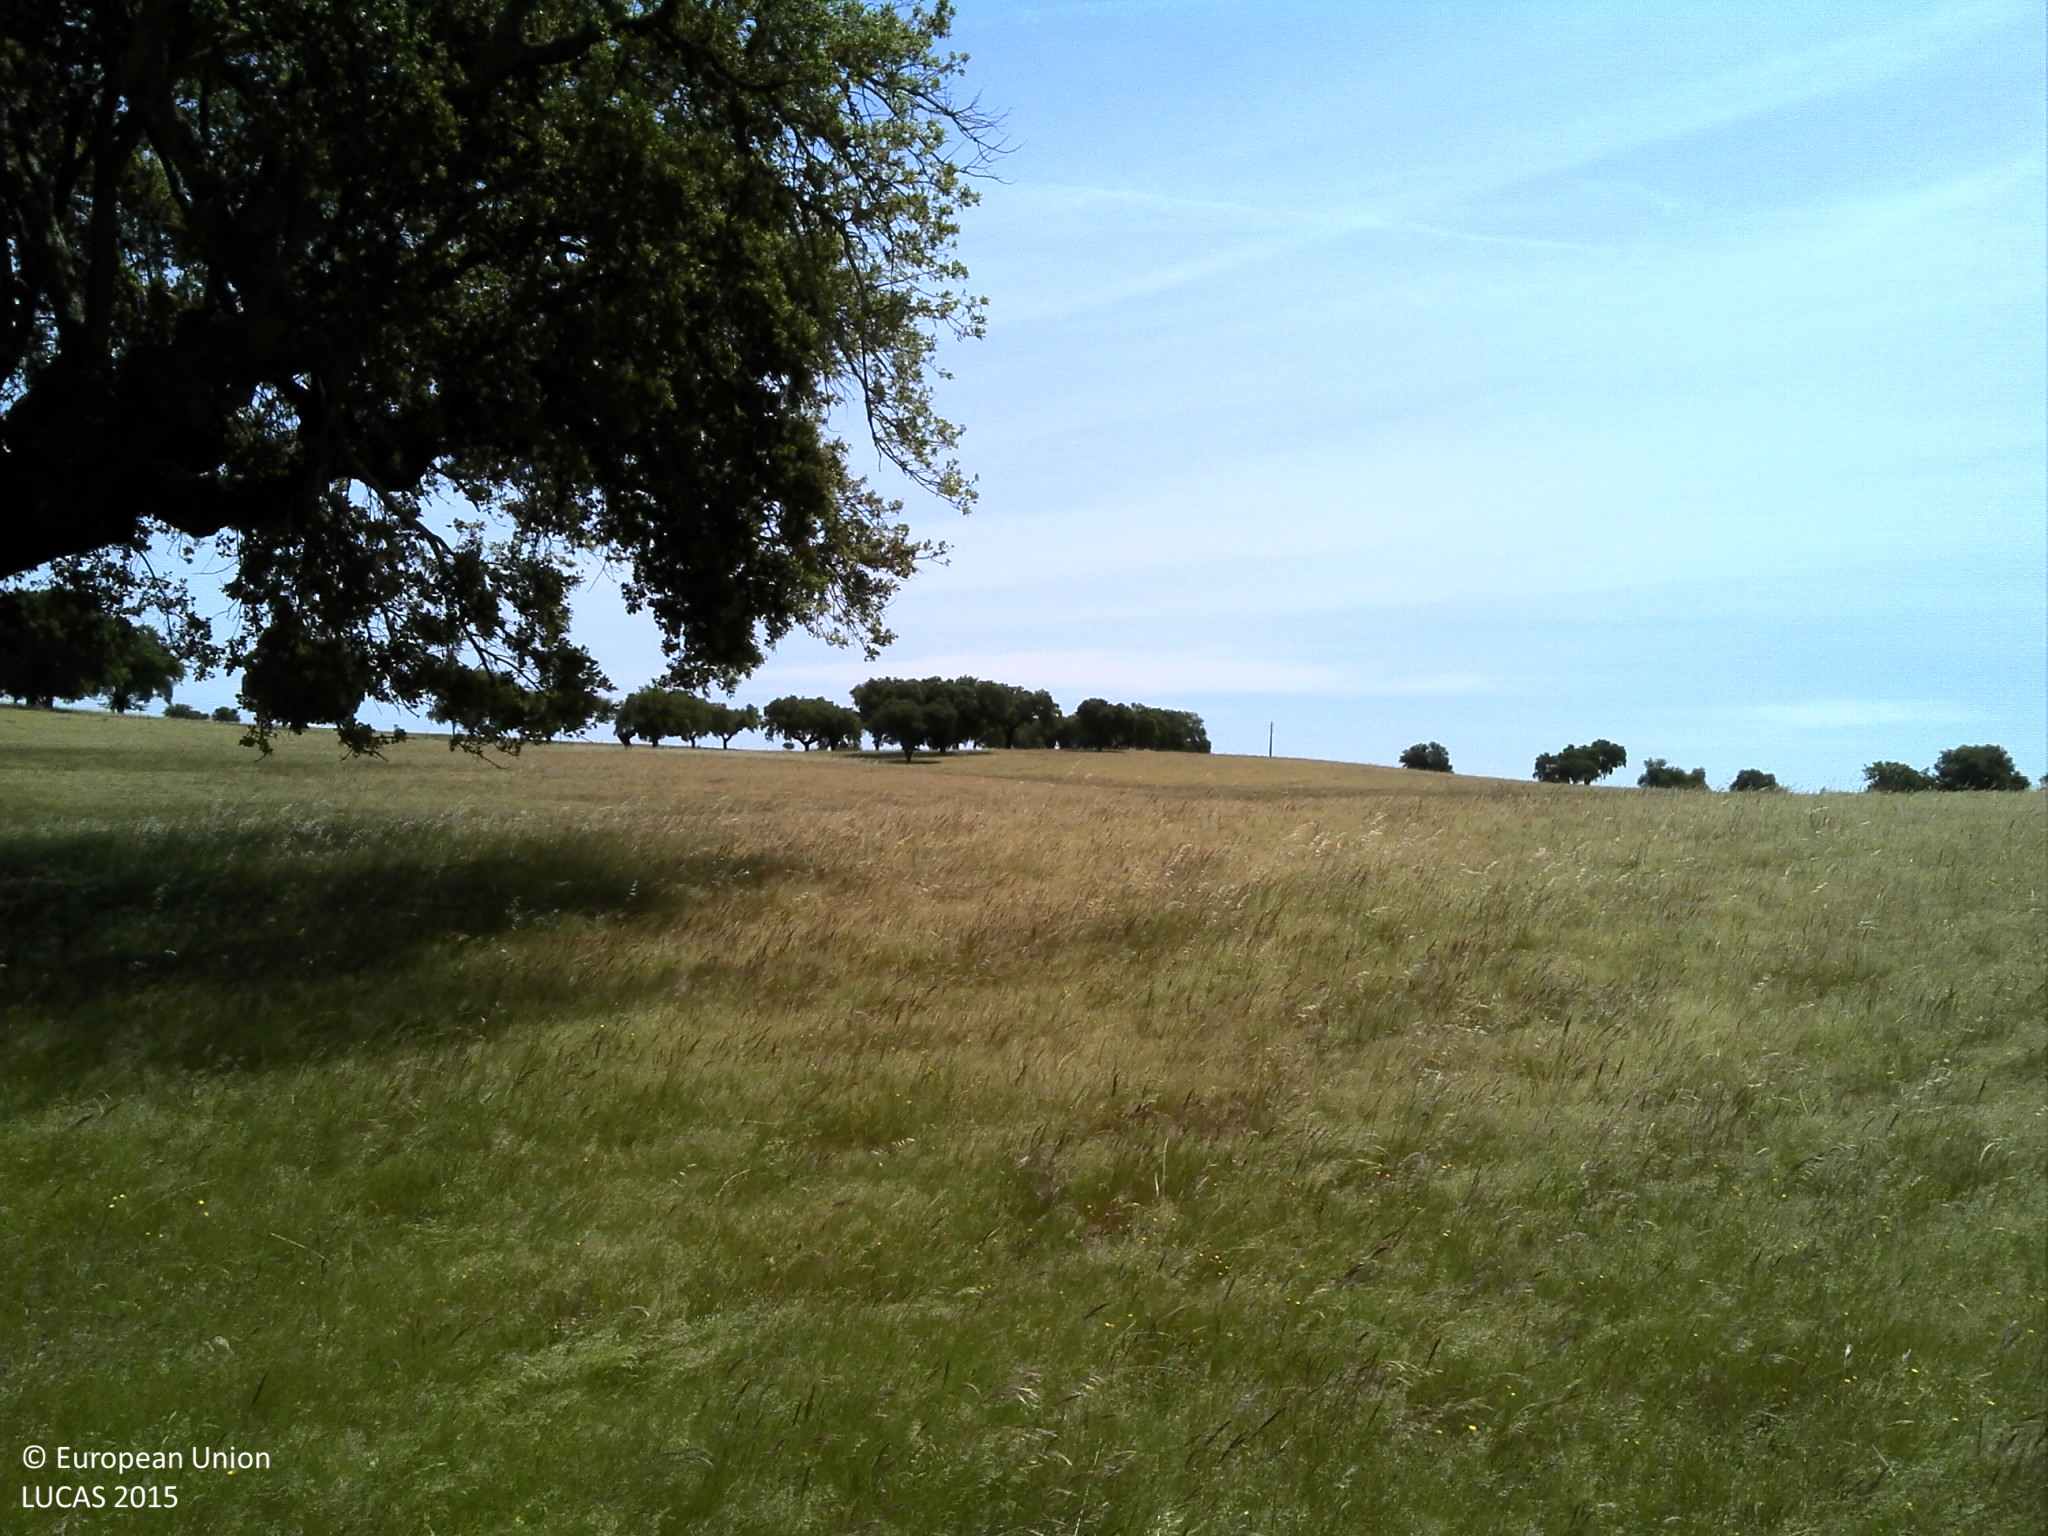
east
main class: Woodland
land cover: Broadleaved woodland
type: broadleaved evergreen forest
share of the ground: 10 - 25 %
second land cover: Grassland without tree/shrub cover
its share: 50 - 75 %
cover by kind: herbaceous plants 75 %, unconsolidated bare surface 15 %, broadleaved forest trees 10 %
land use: Forestry
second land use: Agriculture (excluding fallow land and kitchen gardens)
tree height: > 5 m
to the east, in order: Broadleaved woodland; Grassland without tree/shrub cover
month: May
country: PT
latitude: 39.1132
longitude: -7.6573
